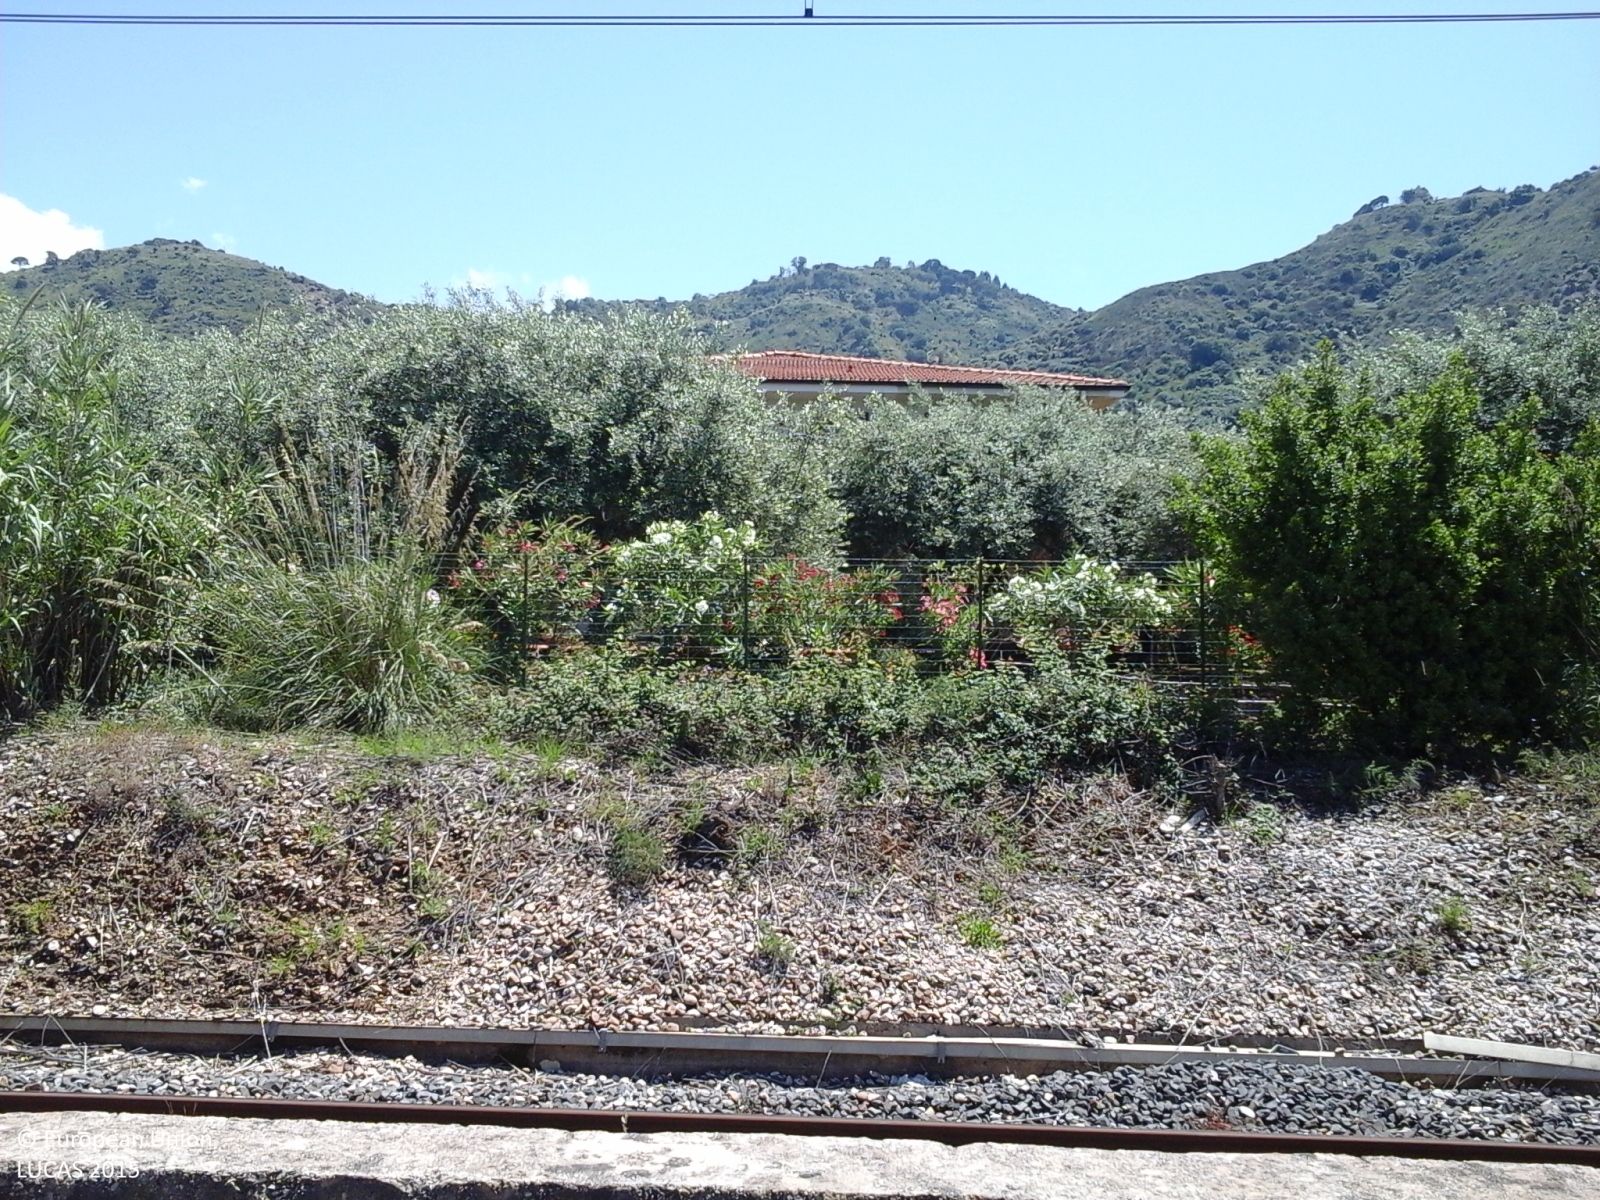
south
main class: Woodland
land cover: Broadleaved woodland
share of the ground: > 75 %
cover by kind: broadleaved forest trees 85 %, shrubs 10 %, herbaceous plants 5 %
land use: Residential
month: May
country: IT
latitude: 38.0280
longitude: 13.9712
